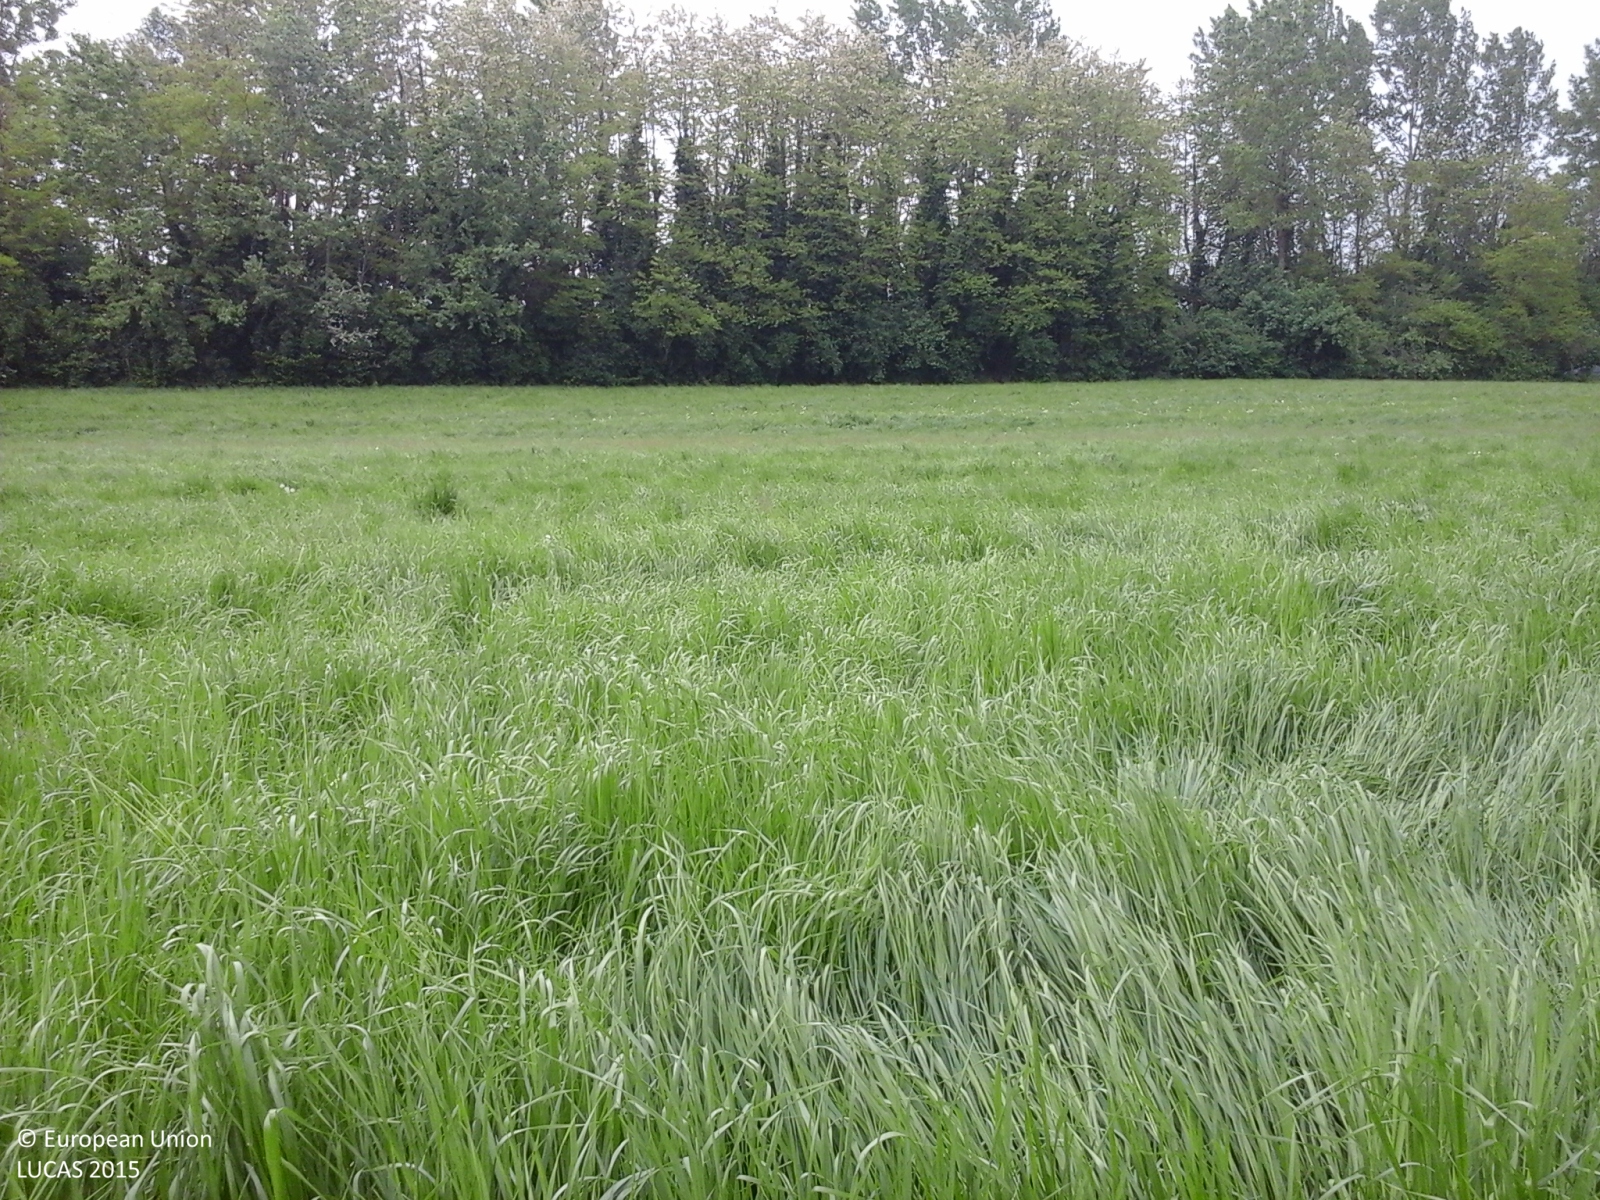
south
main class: Cropland
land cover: Temporary grasslands
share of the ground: > 75 %
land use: Agriculture (excluding fallow land and kitchen gardens)
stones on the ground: < 10 %
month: May
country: IT
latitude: 44.5376
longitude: 7.5257
